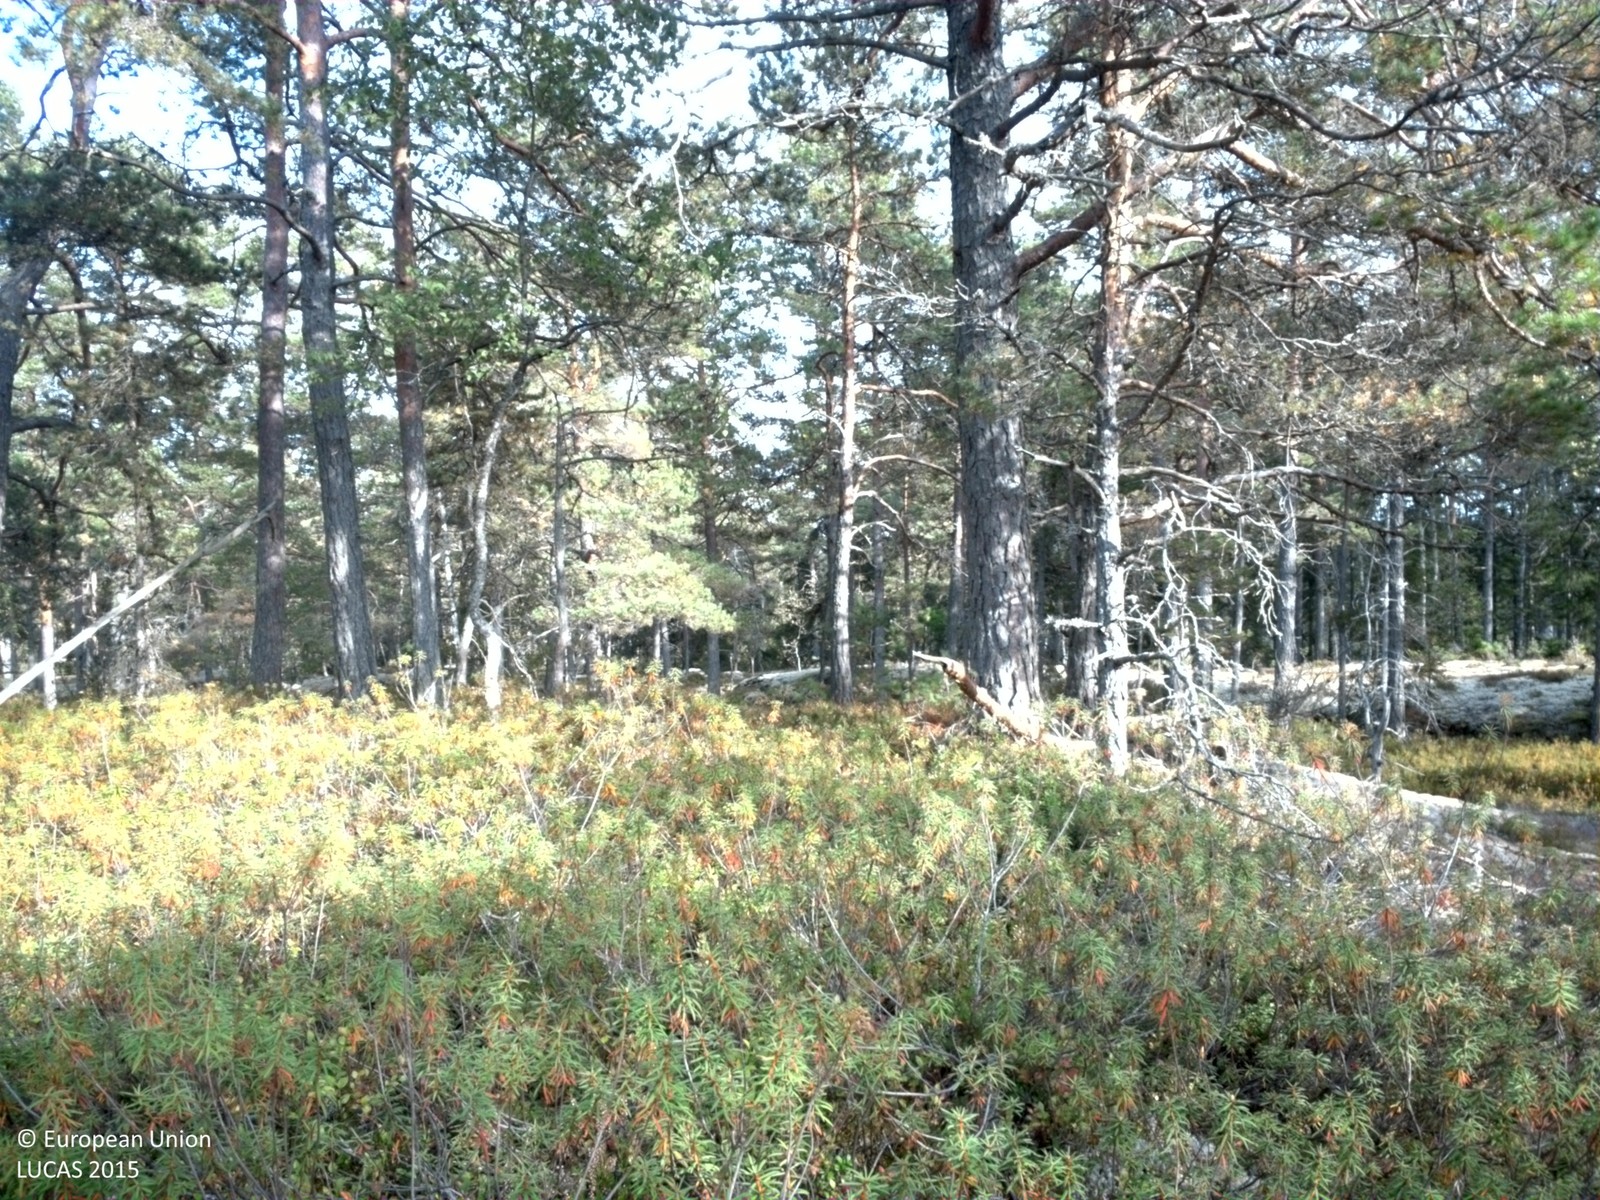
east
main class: Woodland
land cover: Pine dominated coniferous woodland
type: boreal forest
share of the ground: 50 - 75 %
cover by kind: coniferous forest trees 60 %, shrubs 20 %, consolidated bare surface 15 %, lichens and mosses 5 %
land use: Forestry
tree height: > 5 m
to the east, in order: Pine dominated coniferous woodland; Other coniferous woodland; Pine dominated mixed woodland; Spruce dominated mixed woodland; Spruce dominated coniferous woodland
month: September
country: SE
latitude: 59.8131
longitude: 18.8262
